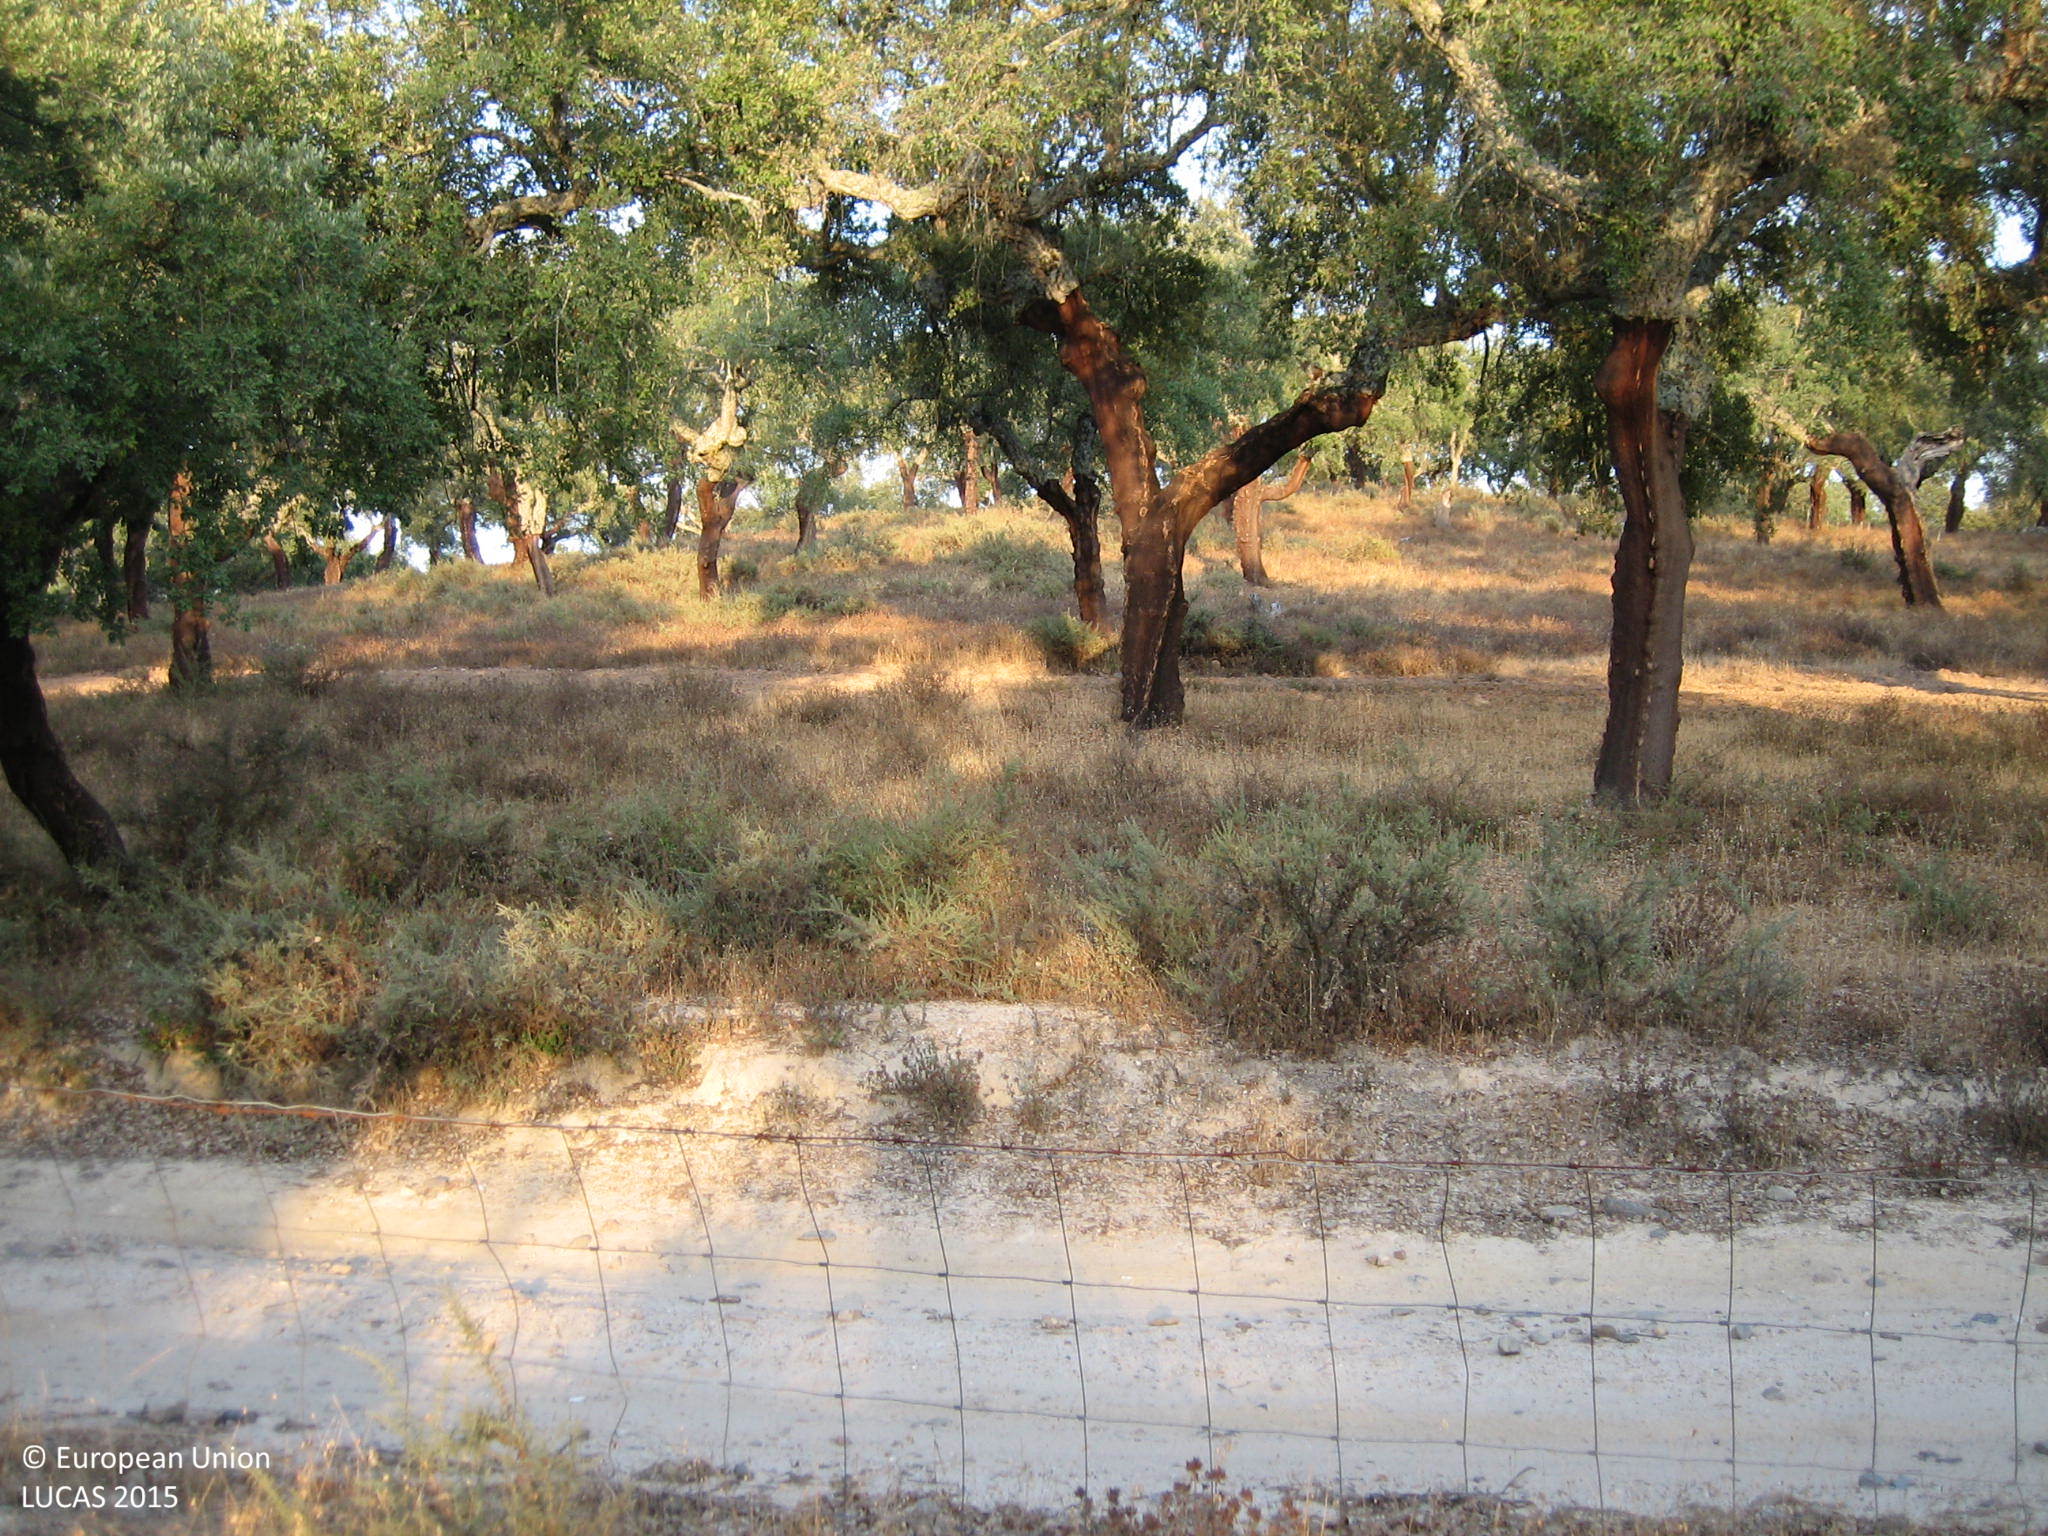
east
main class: Woodland
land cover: Broadleaved woodland
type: broadleaved evergreen forest
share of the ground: 50 - 75 %
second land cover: Grassland without tree/shrub cover
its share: 10 - 25 %
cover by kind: broadleaved forest trees 50 %, unconsolidated bare surface 40 %, herbaceous plants 10 %
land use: Forestry
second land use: Agriculture (excluding fallow land and kitchen gardens)
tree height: > 5 m
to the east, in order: Broadleaved woodland; Grassland without tree/shrub cover; Fences; Tracks; Broadleaved woodland; Other structural elements; Broadleaved woodland; Fences; Dry stone walls; Broadleaved woodland
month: September
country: ES
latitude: 38.3699
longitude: -6.8722
